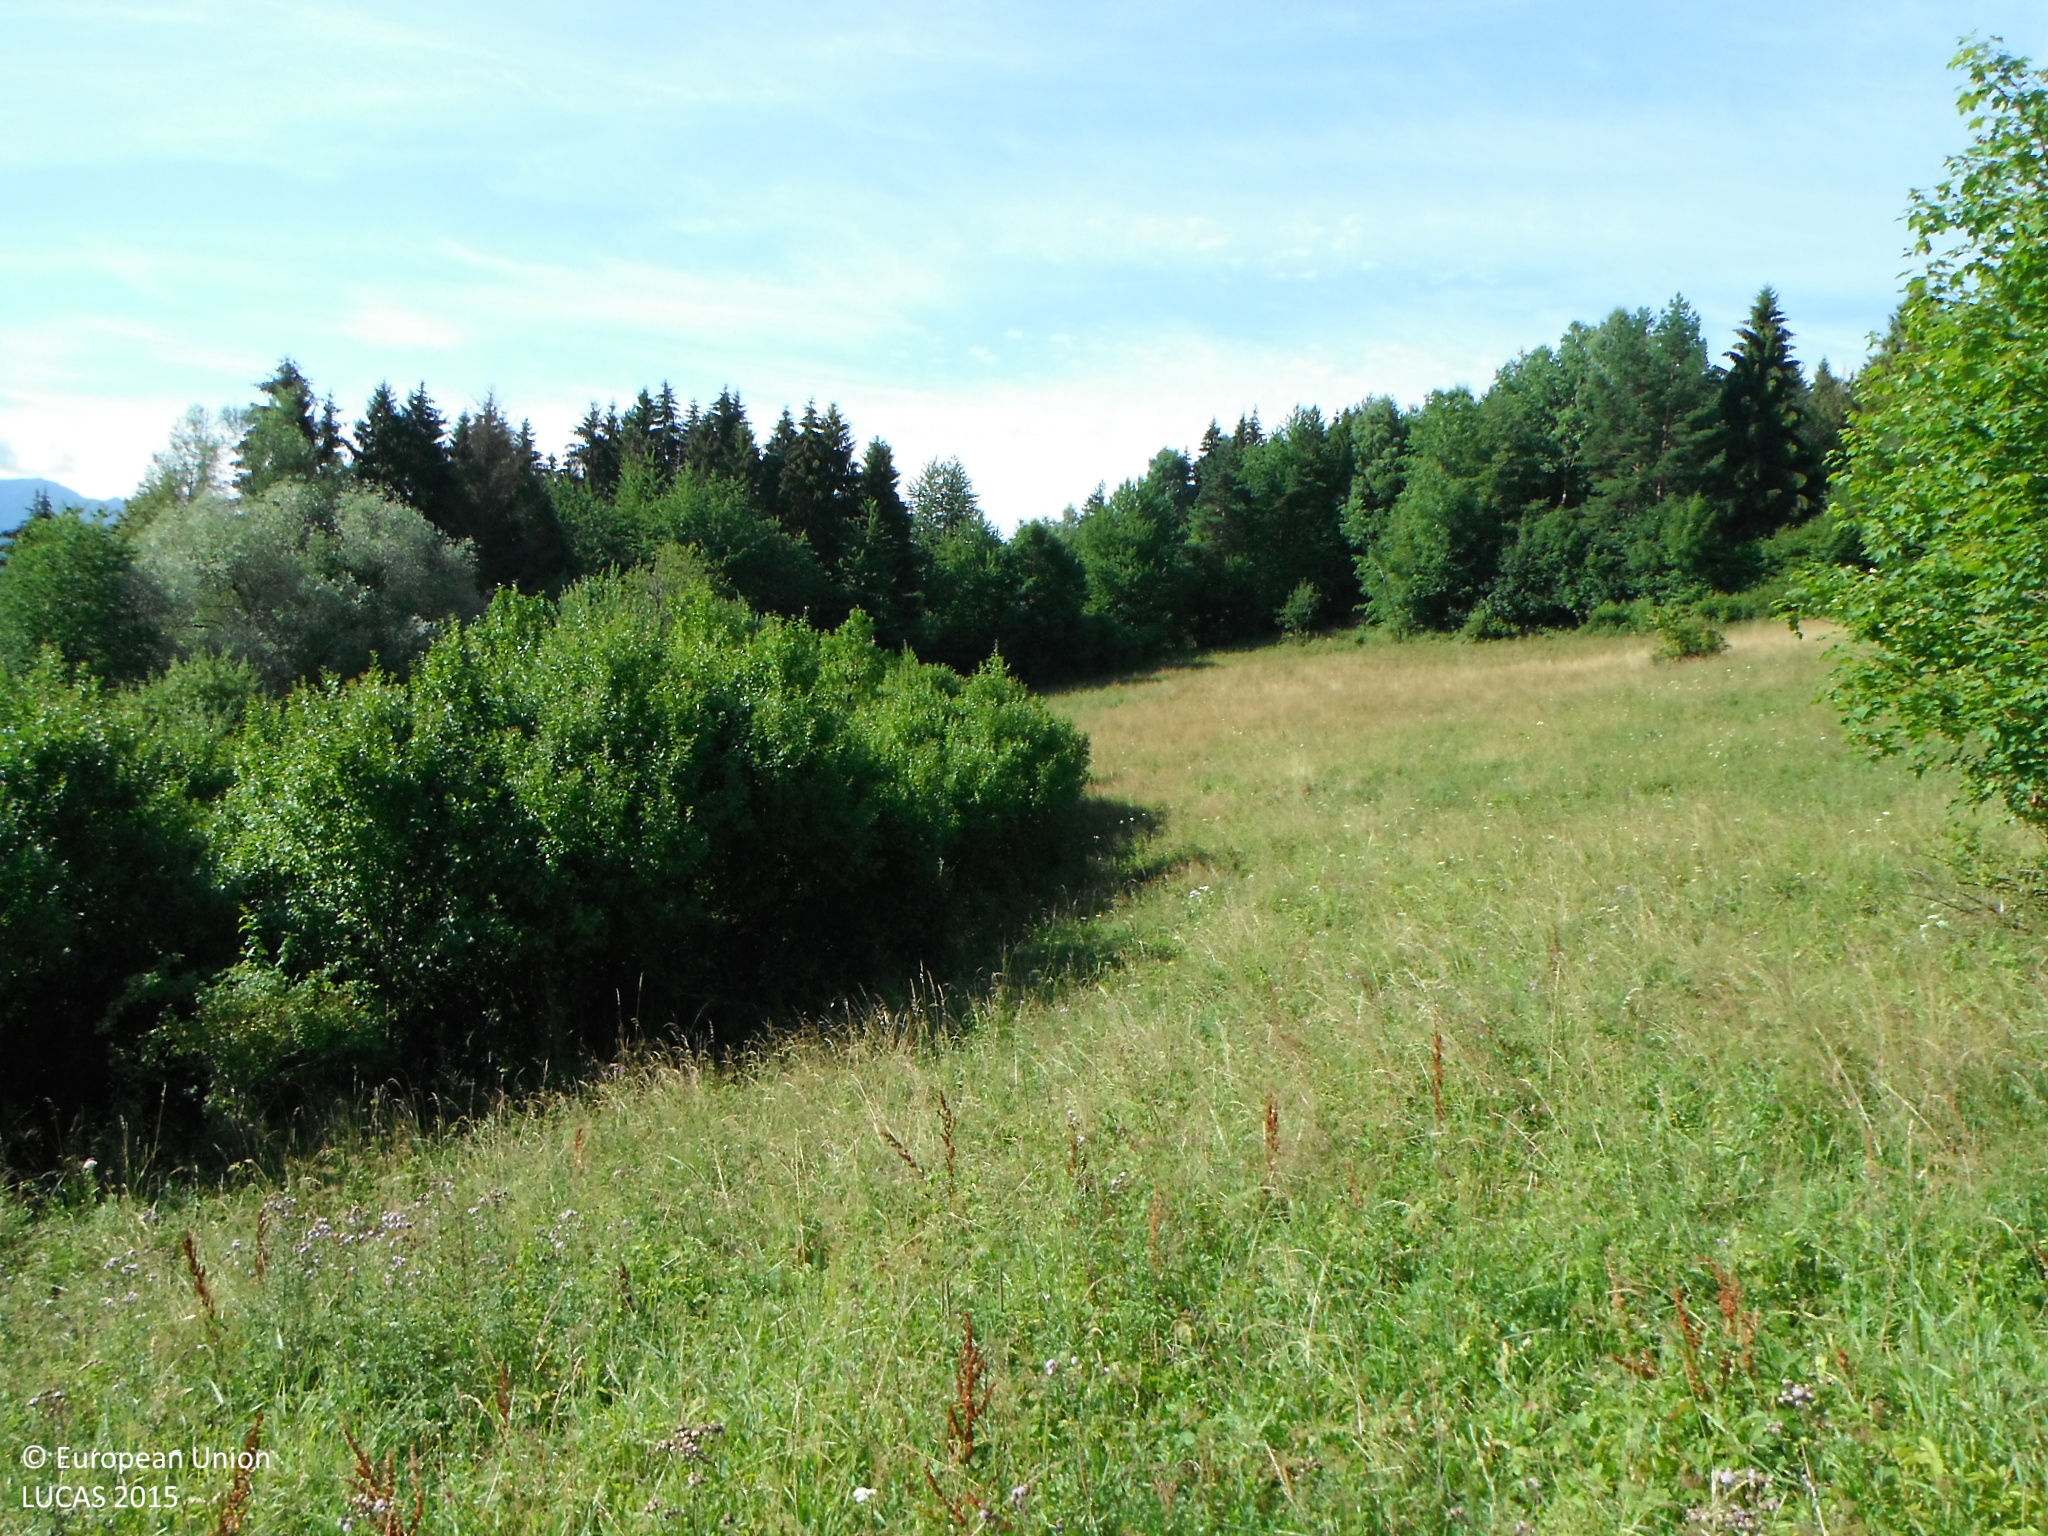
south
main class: Grassland
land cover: Spontaneously vegetated surfaces
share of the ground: > 75 %
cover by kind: herbaceous plants 100 %
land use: Fallow land
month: July
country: SK
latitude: 49.2557
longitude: 18.9108
